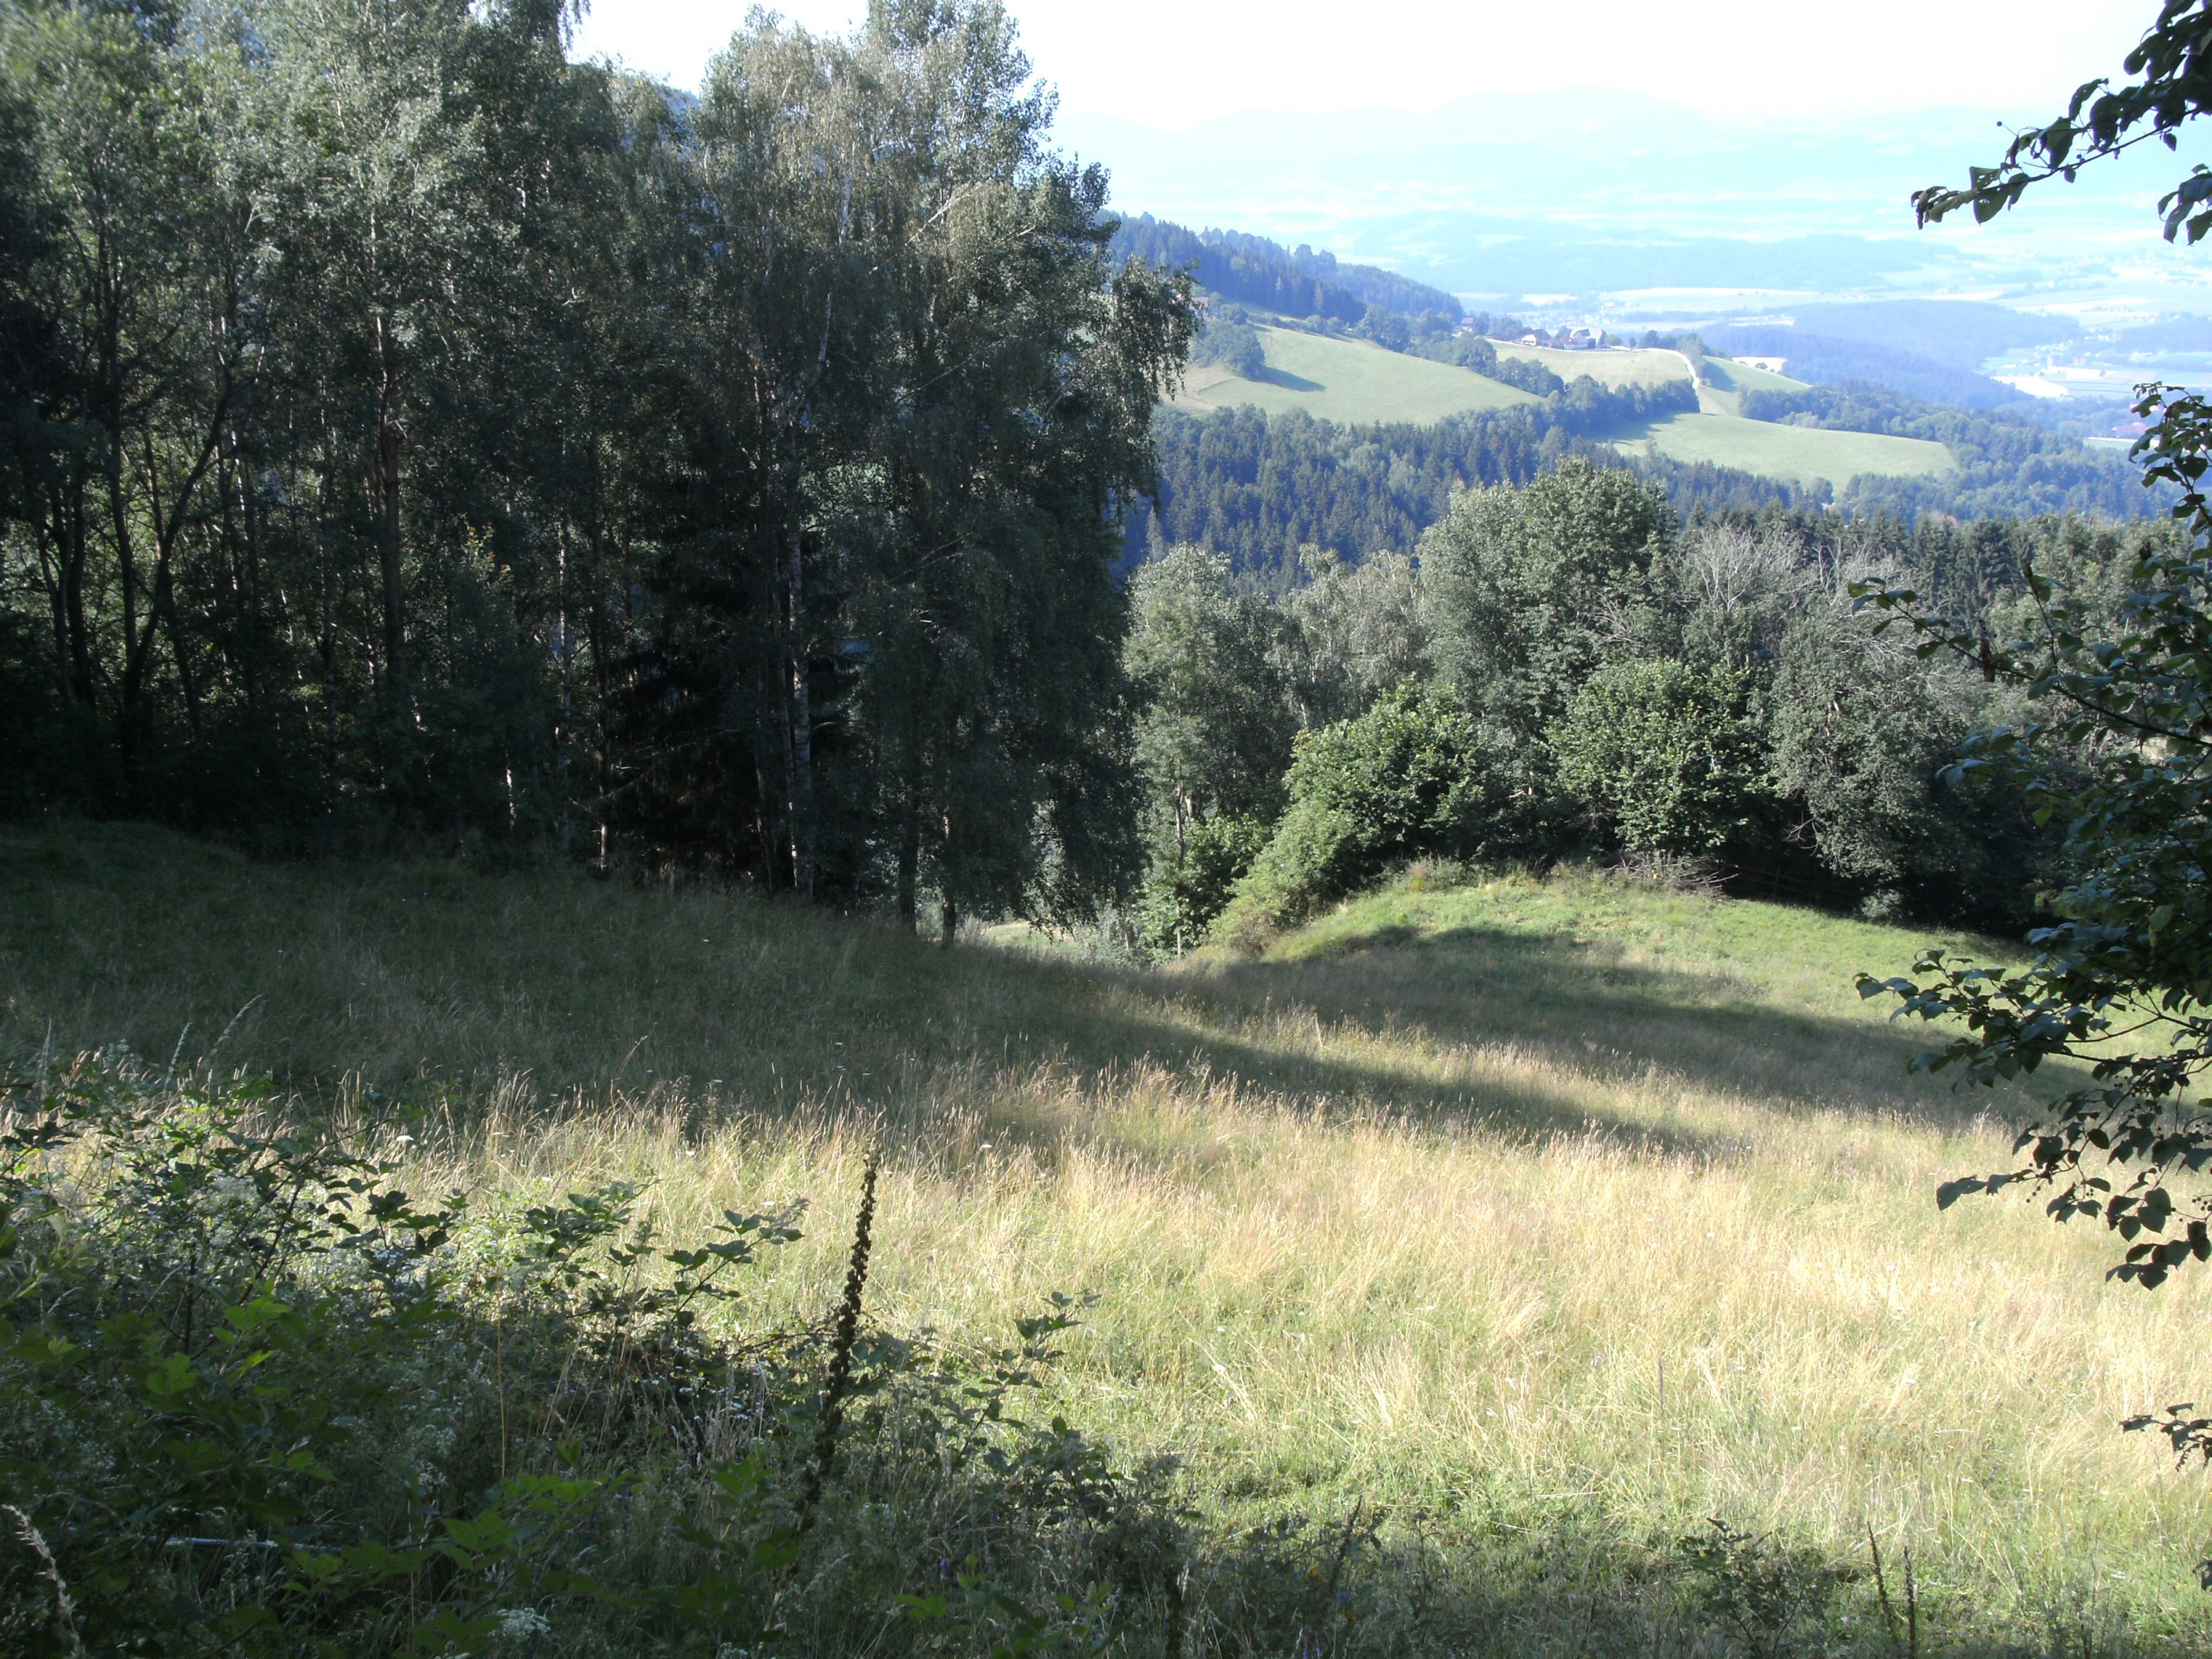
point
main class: Grassland
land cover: Grassland without tree/shrub cover
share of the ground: > 75 %
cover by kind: herbaceous plants 100 %
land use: Agriculture (excluding fallow land and kitchen gardens)
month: July
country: AT
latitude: 46.8157
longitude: 14.9133
